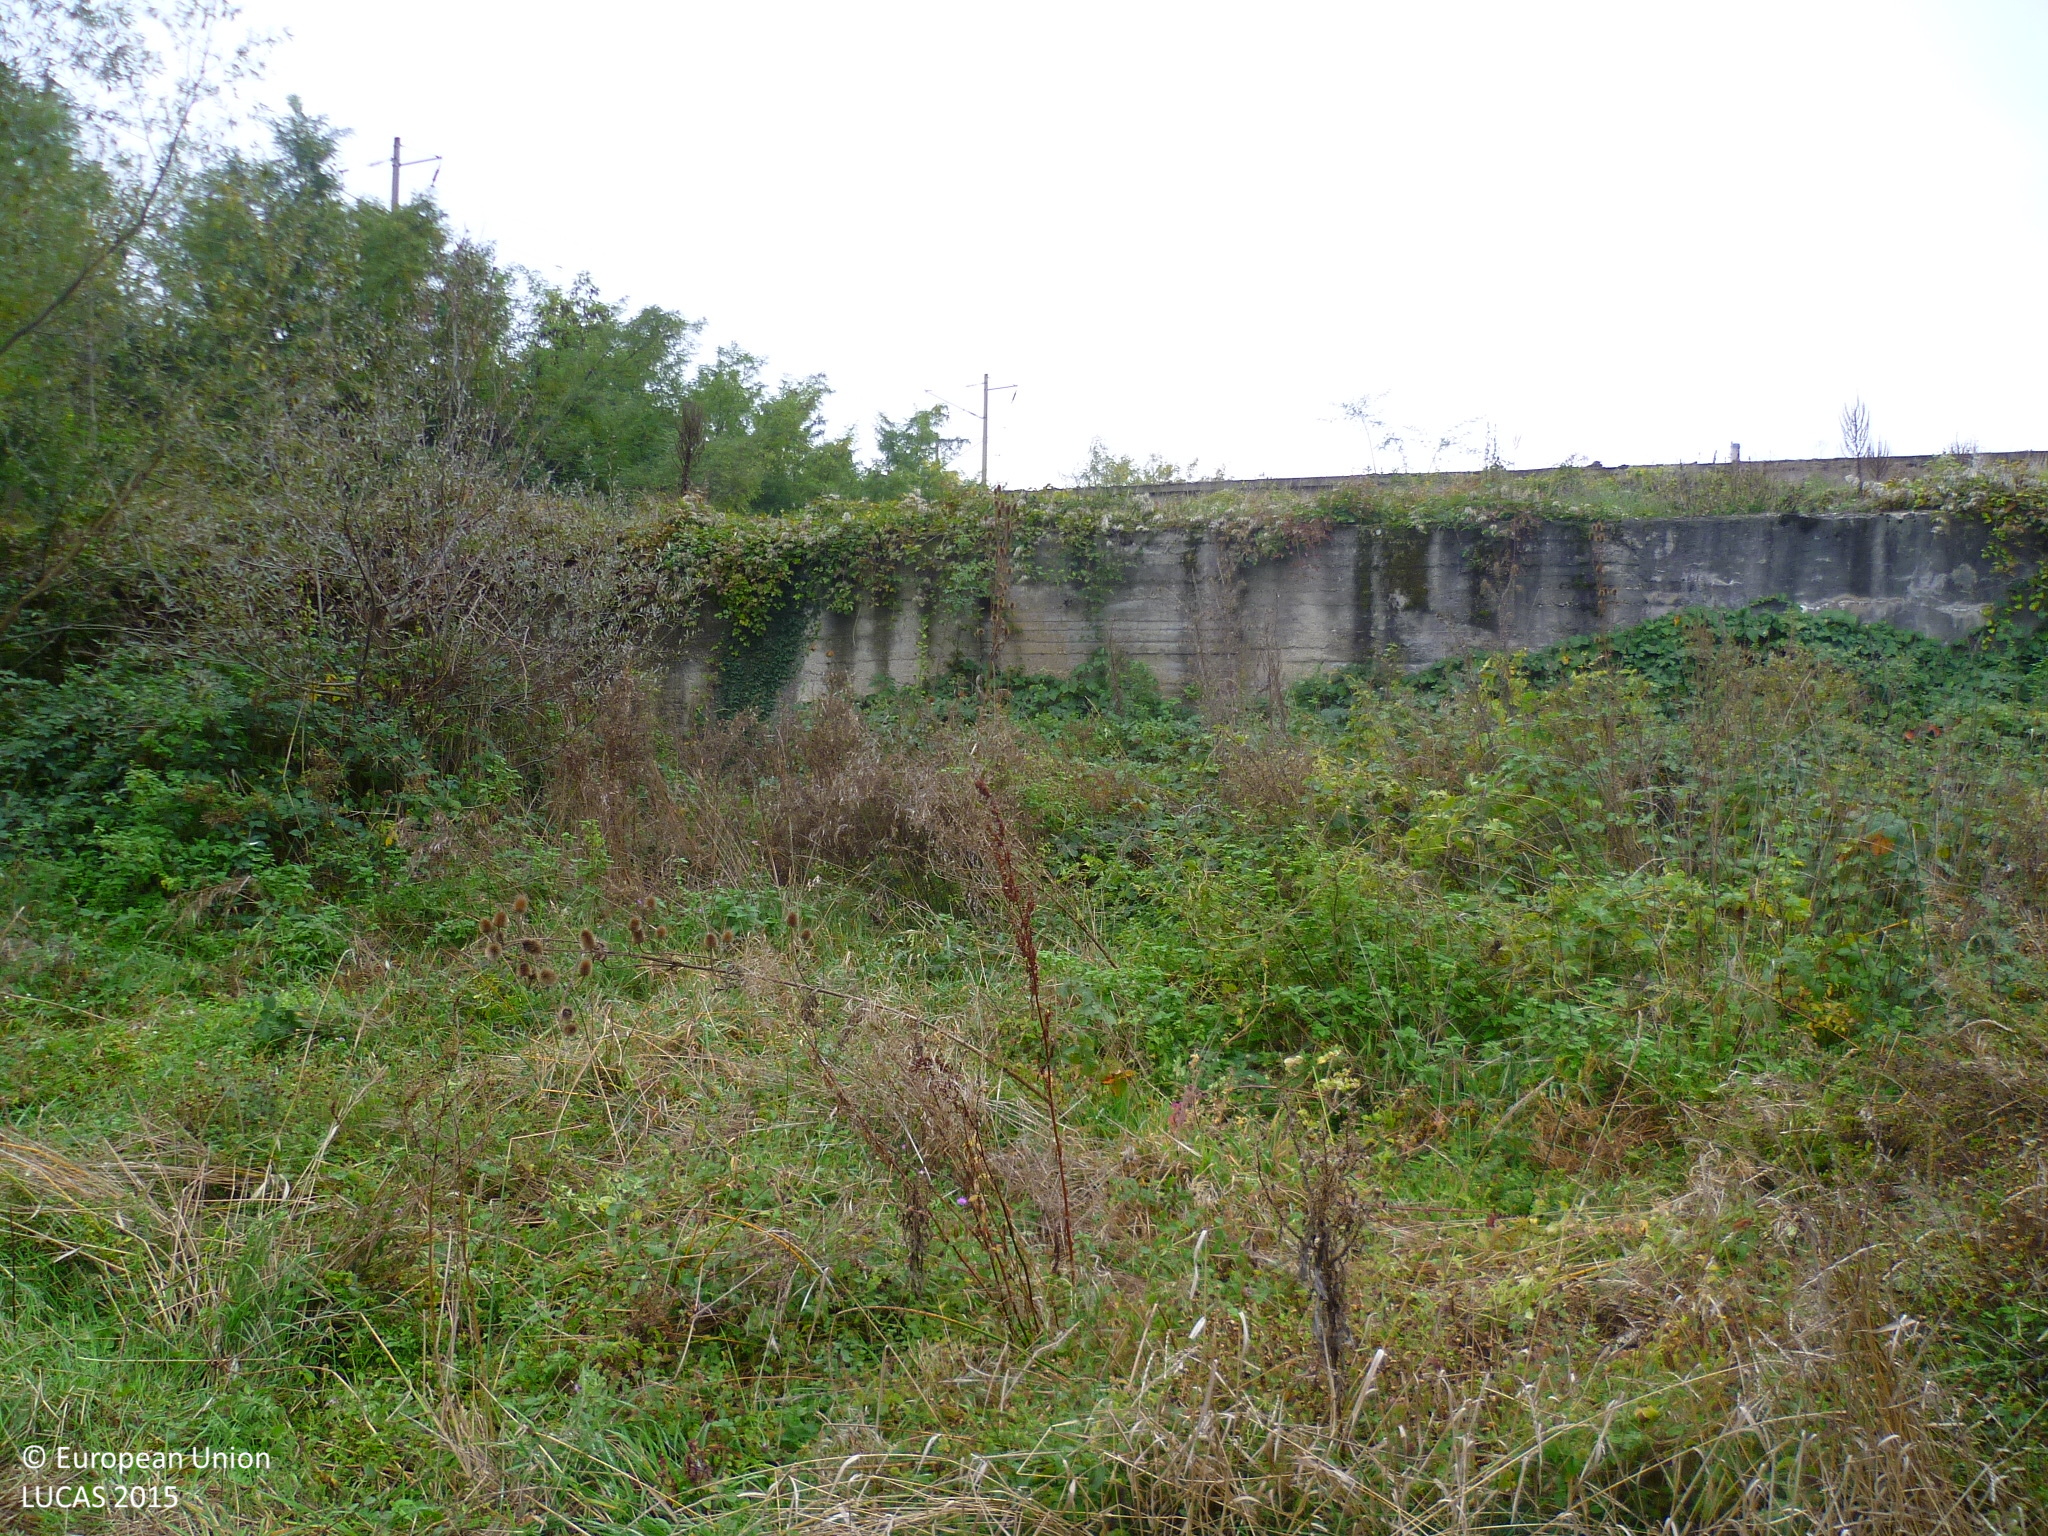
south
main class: Grassland
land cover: Spontaneously vegetated surfaces
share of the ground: > 75 %
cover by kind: herbaceous plants 100 %
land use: Semi-natural and natural areas not in use
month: October
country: BG
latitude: 42.3182
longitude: 23.8584
